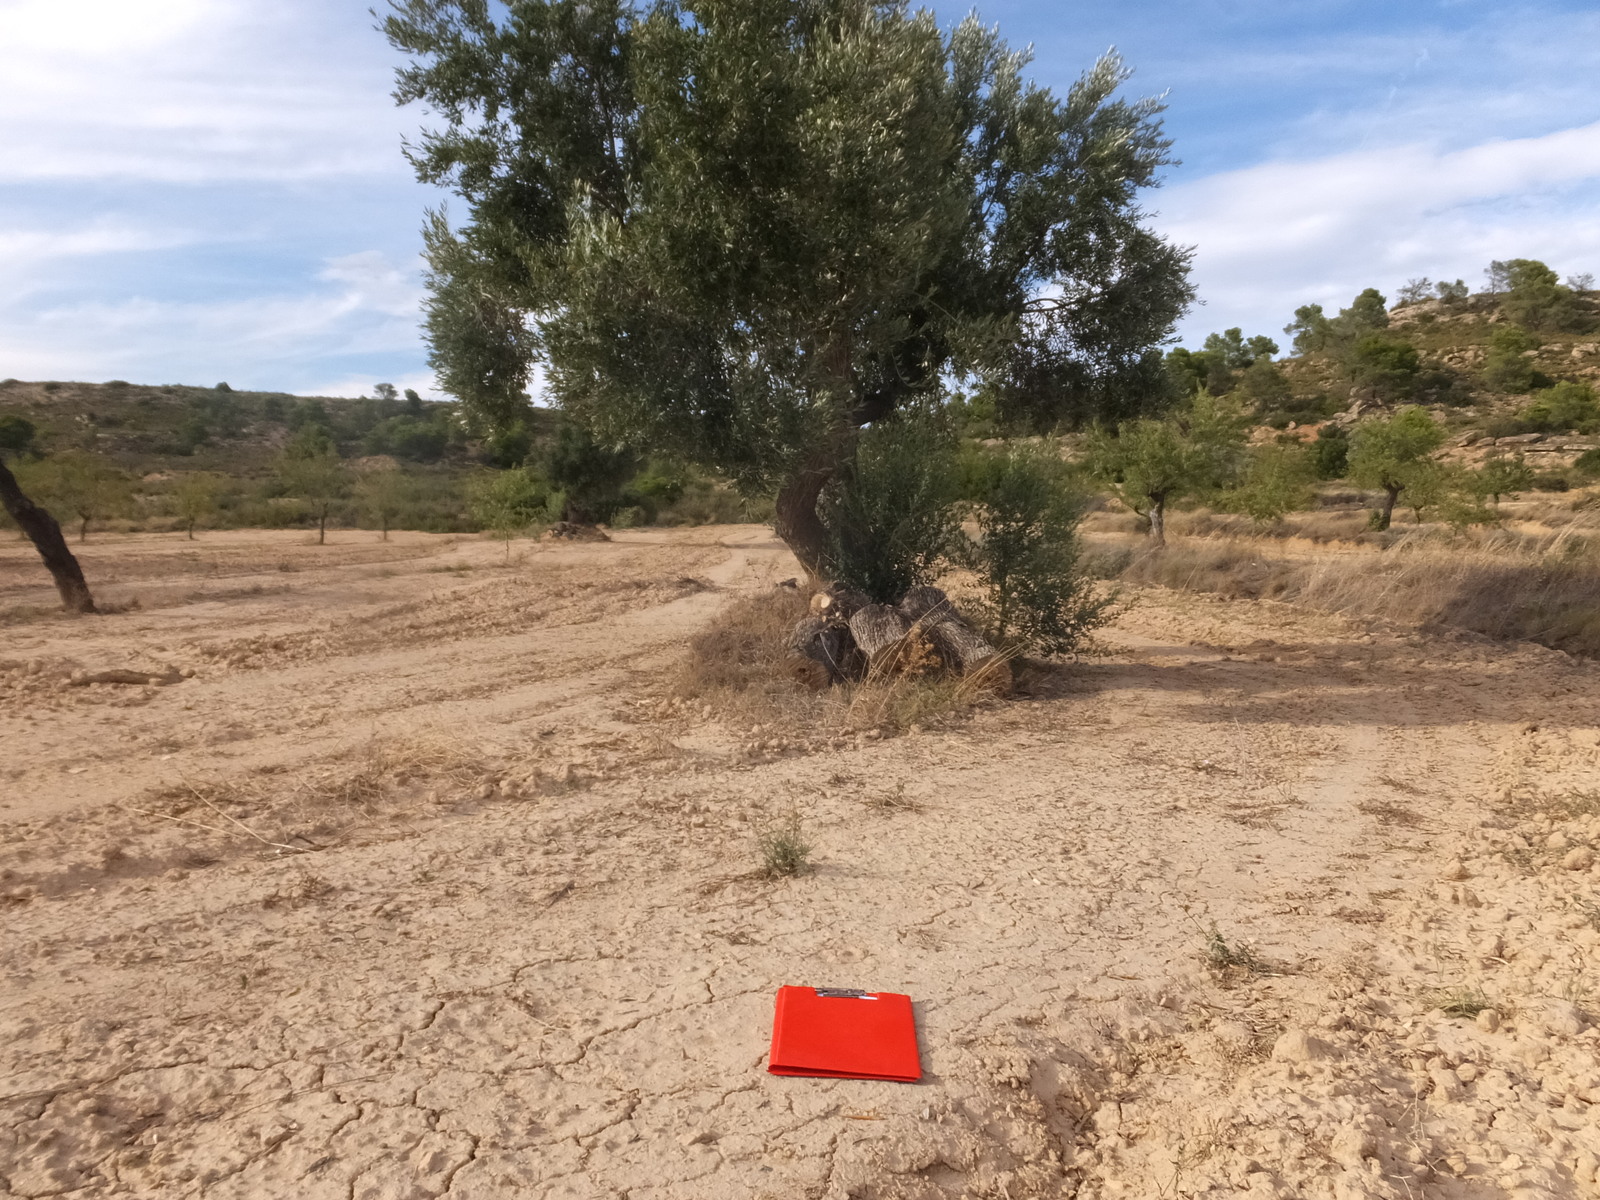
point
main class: Cropland
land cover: Olive groves
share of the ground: > 75 %
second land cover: Other bare soil
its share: > 75 %
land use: Agriculture (excluding fallow land and kitchen gardens)
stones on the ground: 10 - 25 %
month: August
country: ES
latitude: 41.2446
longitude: 0.1439
